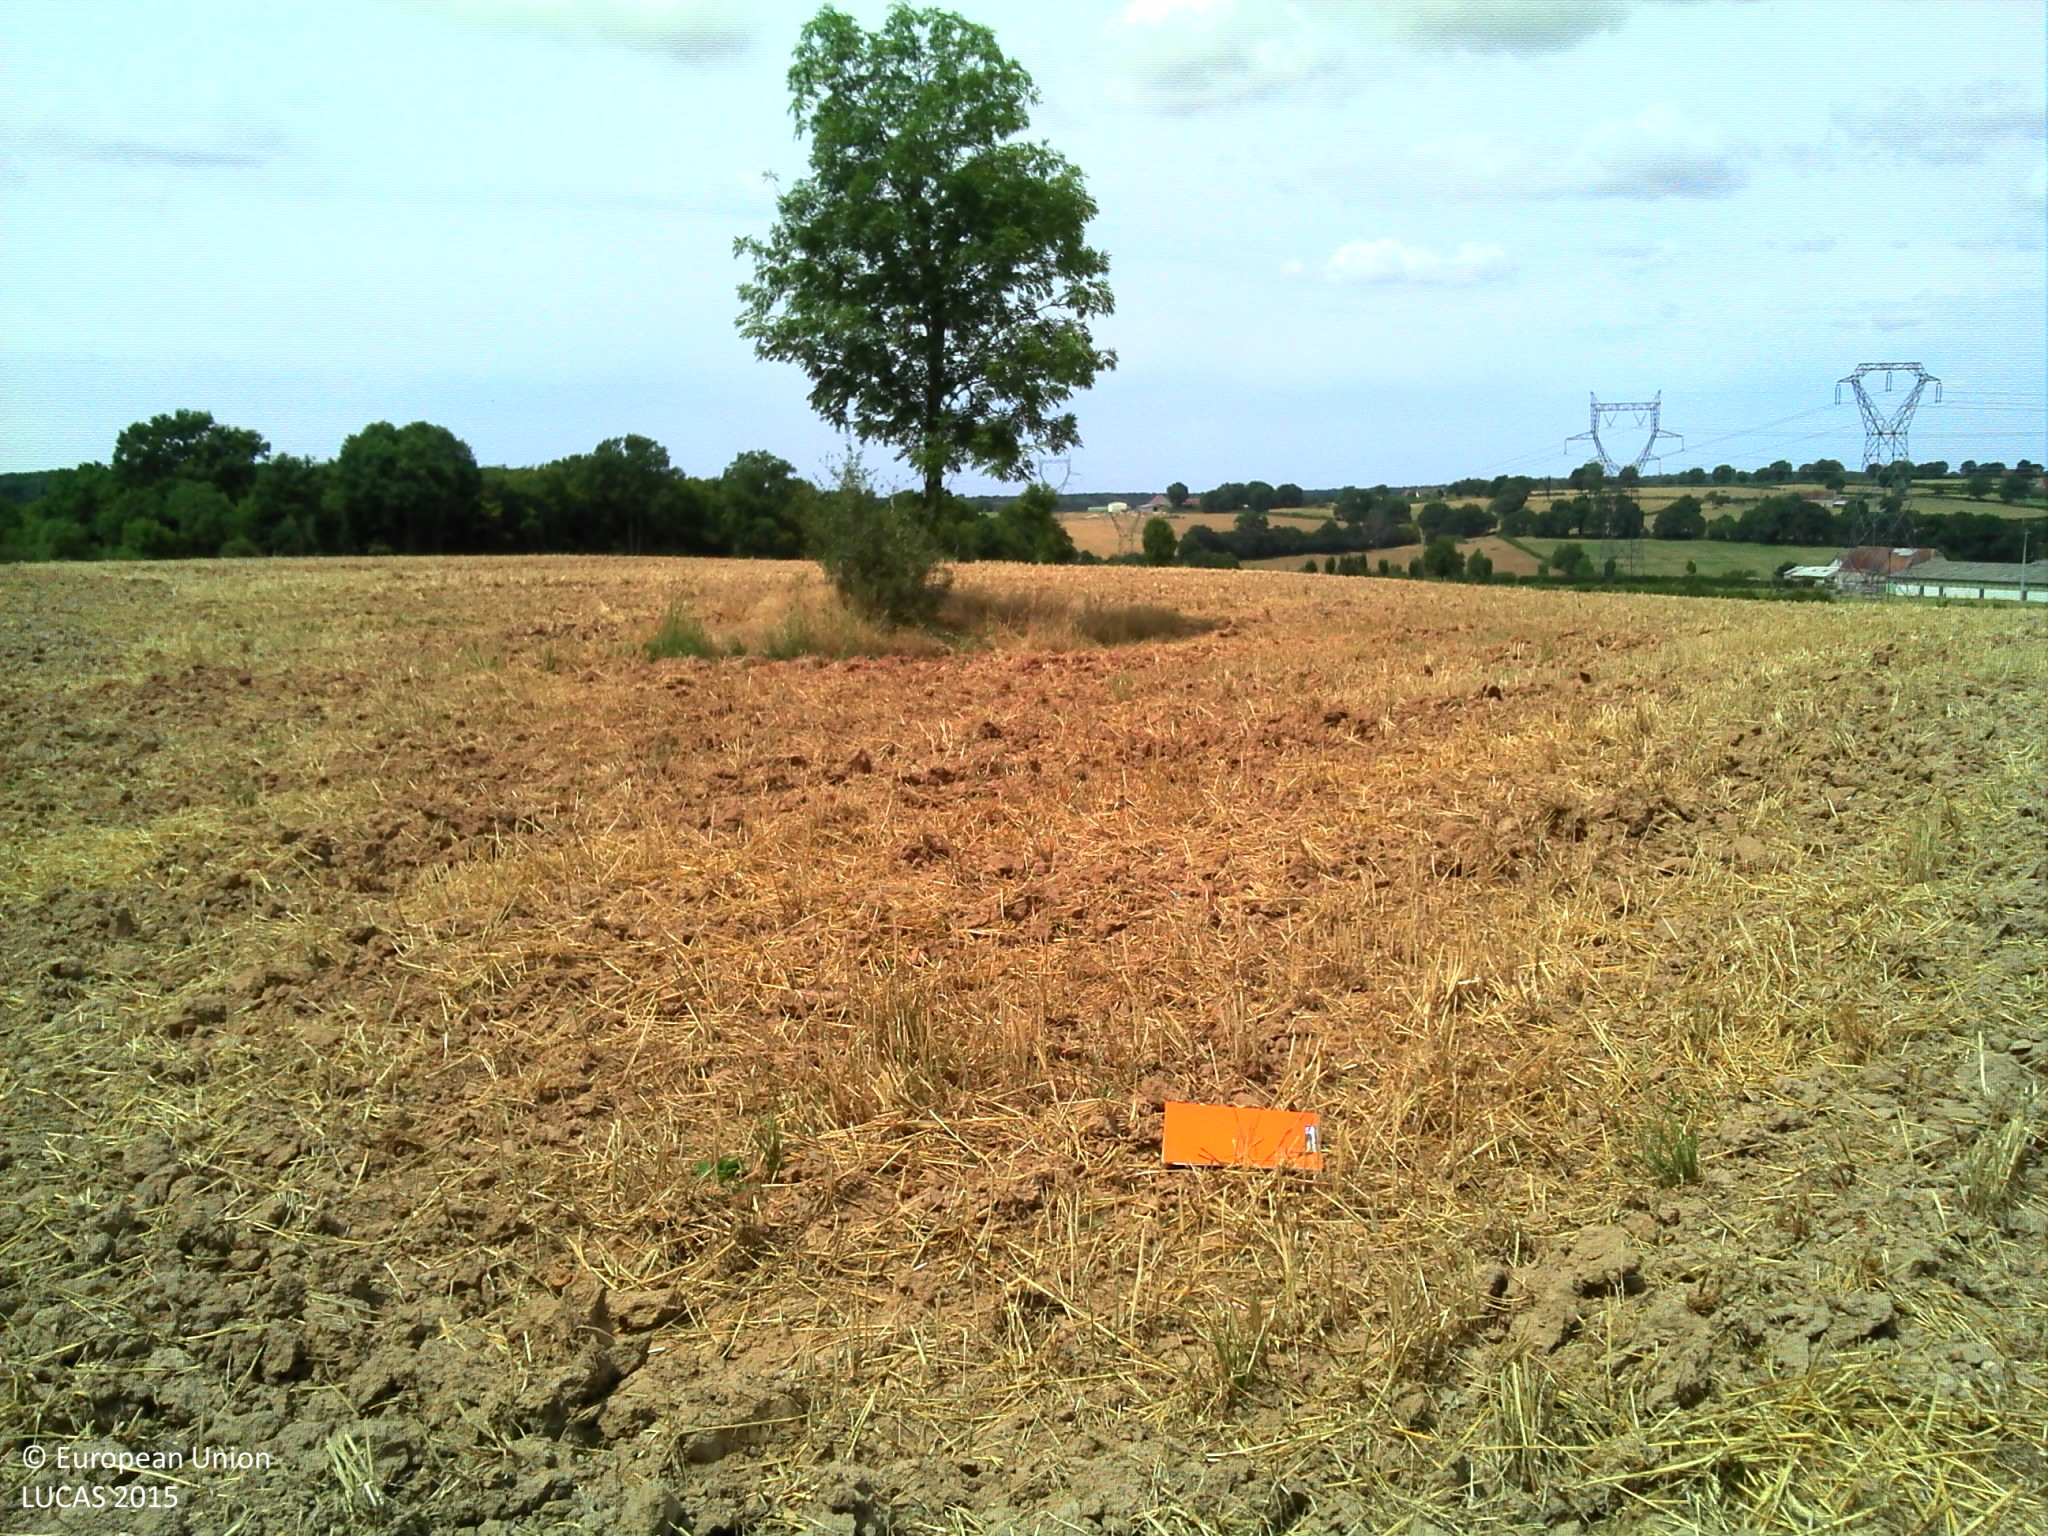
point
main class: Cropland
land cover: Barley
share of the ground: > 75 %
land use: Agriculture (excluding fallow land and kitchen gardens)
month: July
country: FR
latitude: 46.6071
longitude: 2.9595
